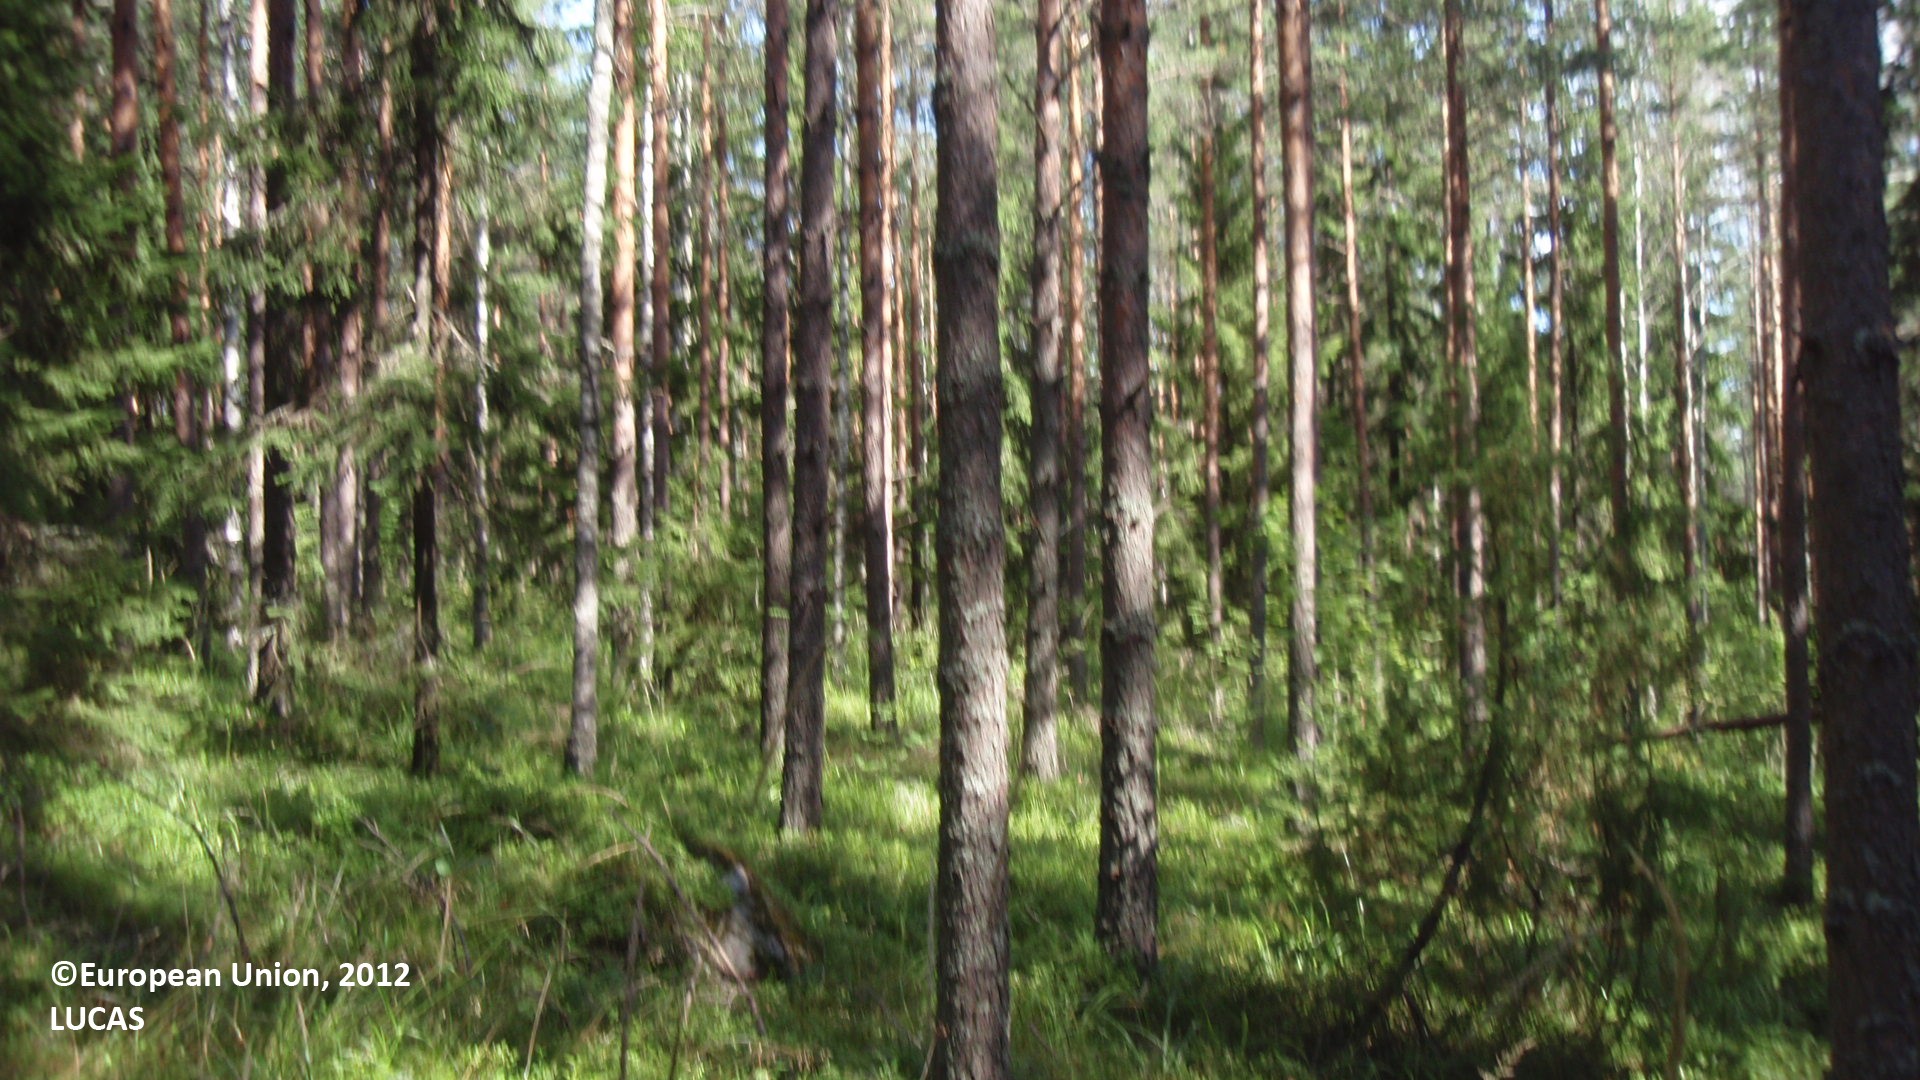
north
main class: Woodland
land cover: Pine dominated mixed woodland
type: boreal forest
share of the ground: 50 - 75 %
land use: Forestry
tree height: > 5 m
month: August
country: FI
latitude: 60.9998
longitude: 28.6578
